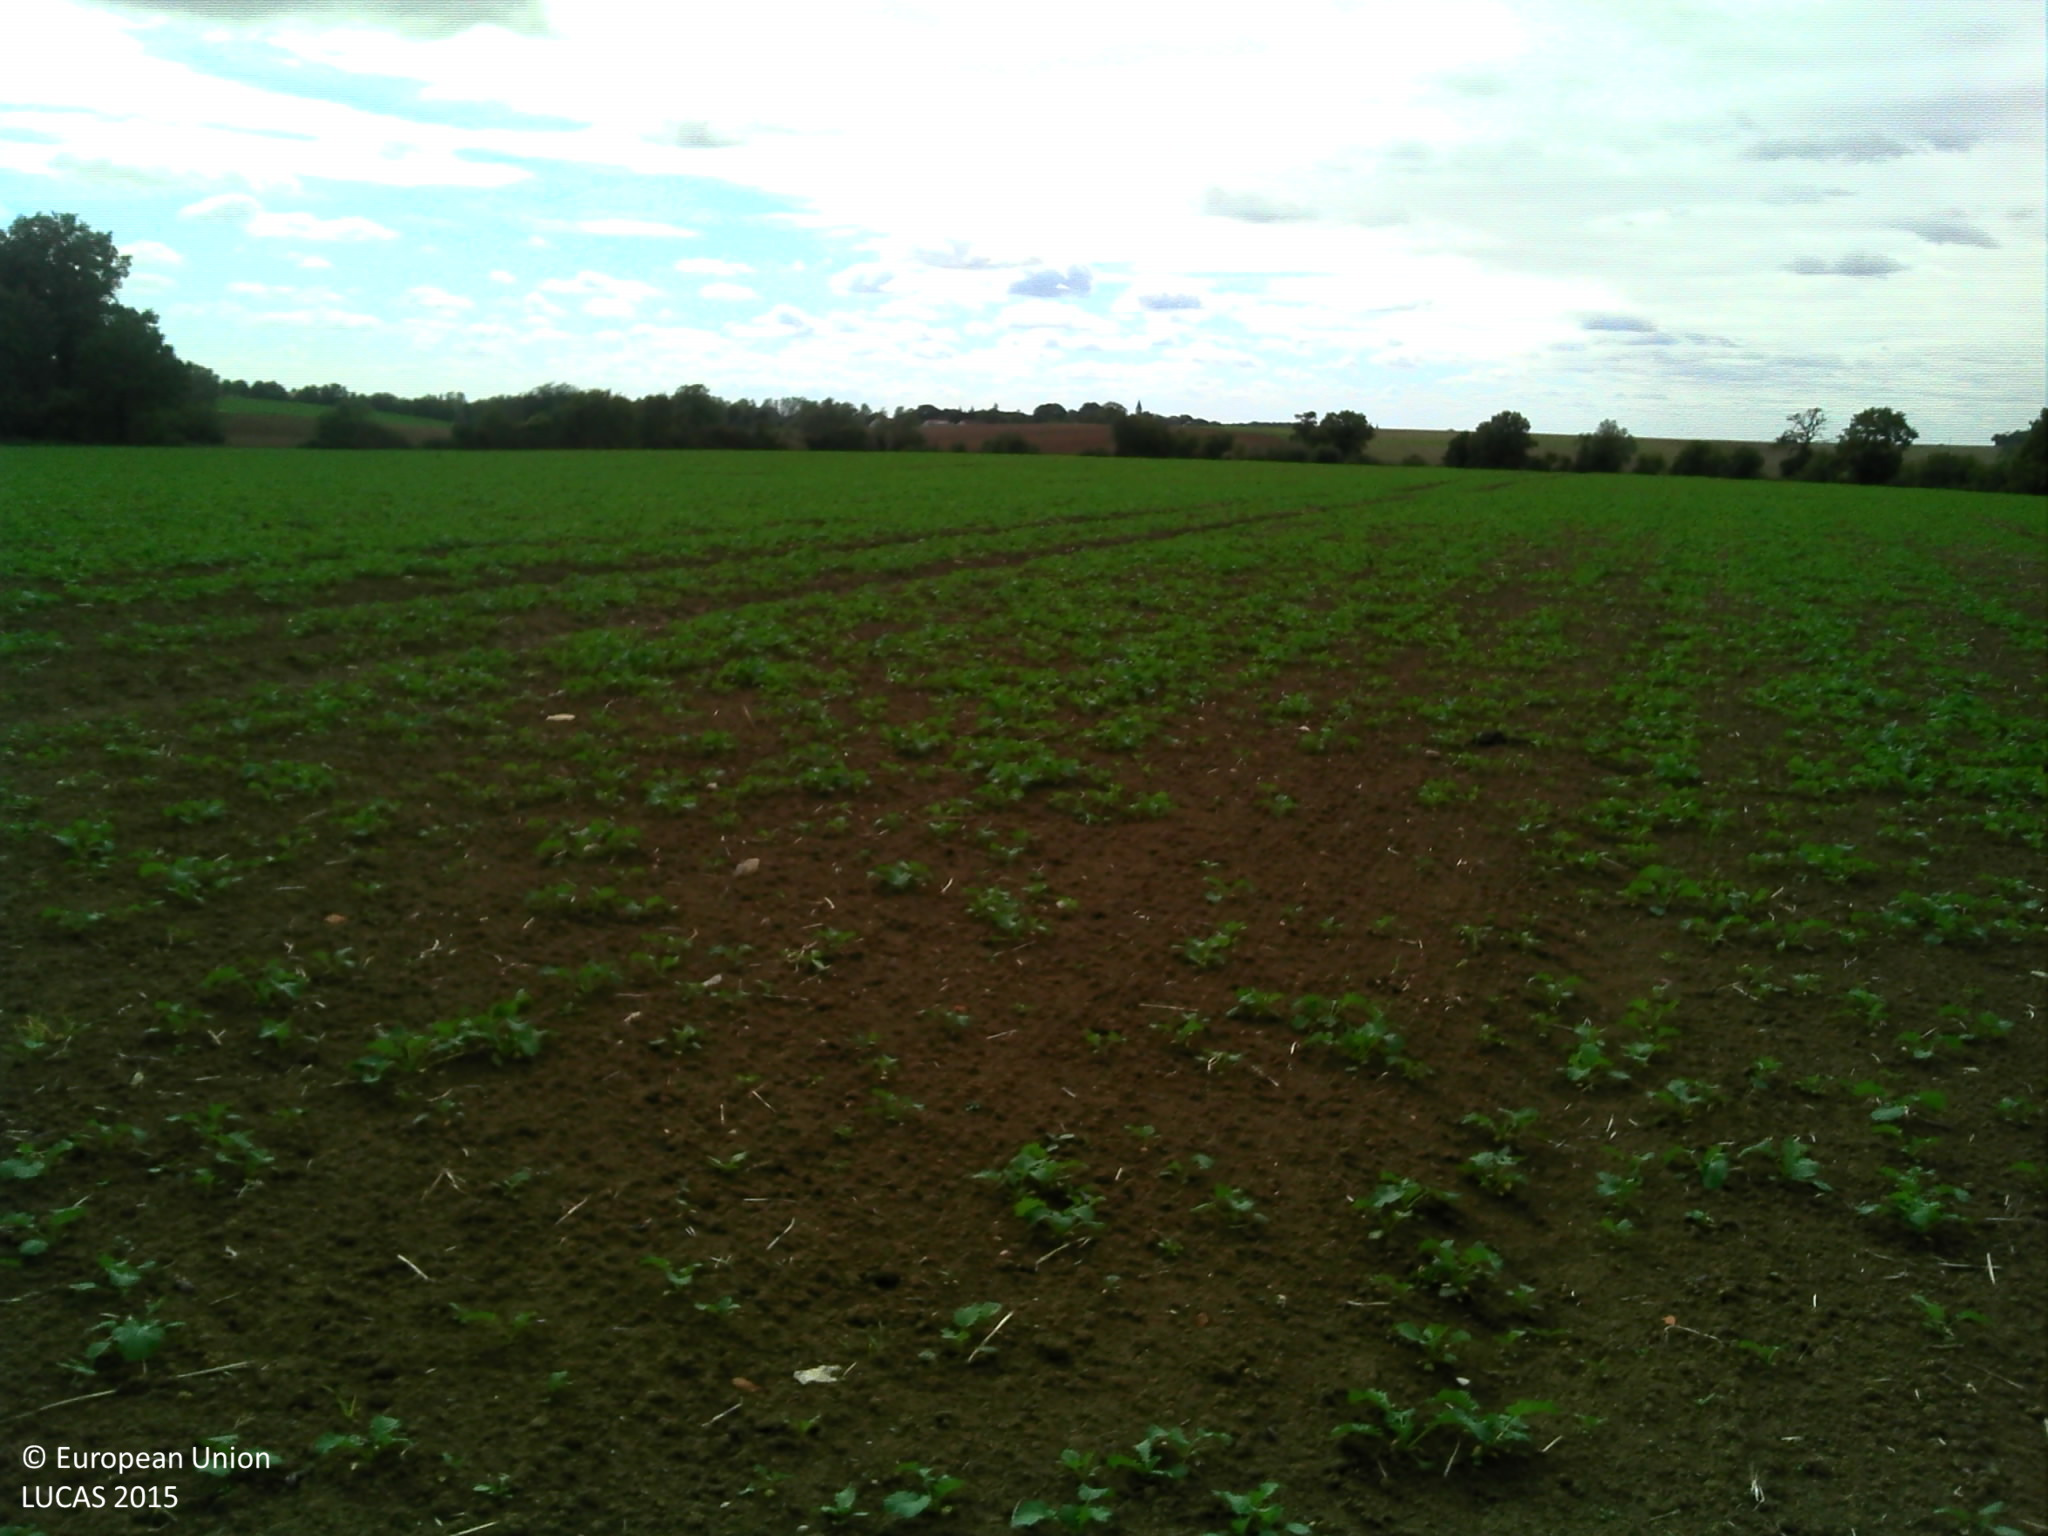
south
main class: Cropland
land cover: Rape and turnip rape
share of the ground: > 75 %
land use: Agriculture (excluding fallow land and kitchen gardens)
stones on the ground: < 10 %
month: June
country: FR
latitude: 47.2326
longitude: 2.5832
